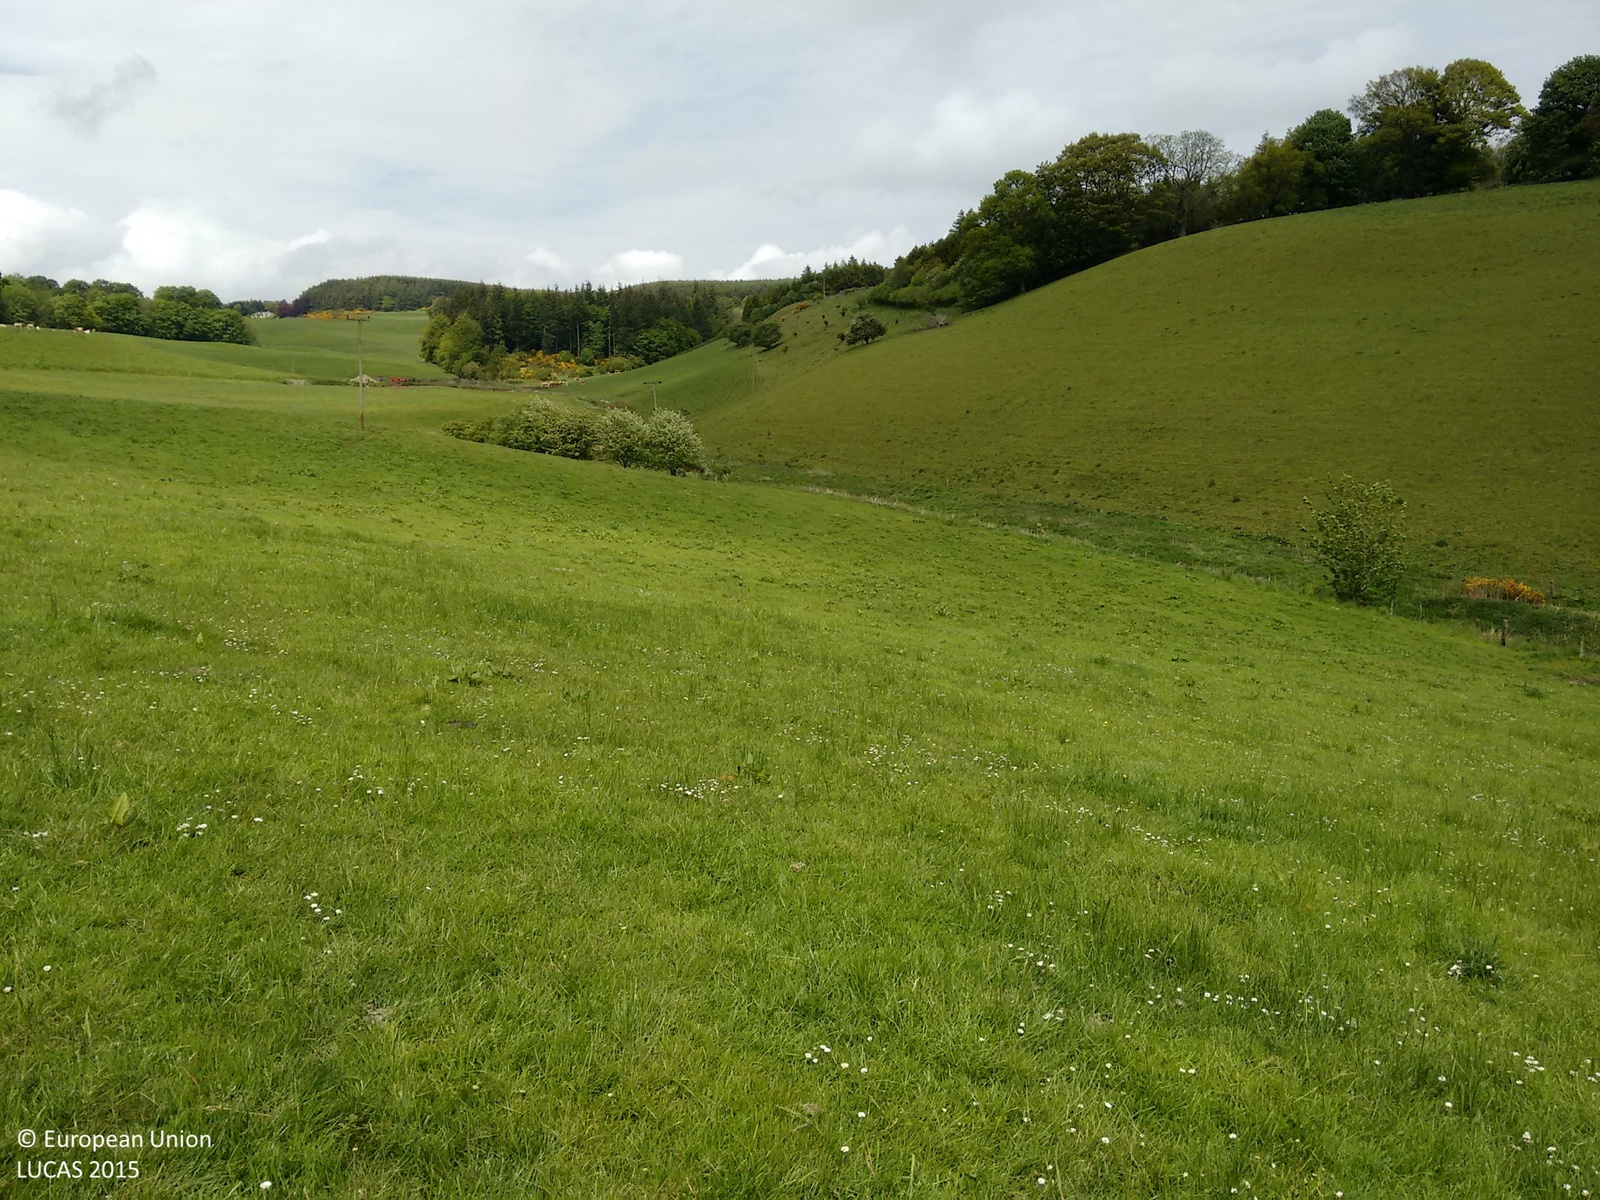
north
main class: Grassland
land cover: Grassland without tree/shrub cover
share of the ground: > 75 %
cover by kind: herbaceous plants 100 %
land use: Agriculture (excluding fallow land and kitchen gardens)
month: June
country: GB
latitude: 56.2939
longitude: -3.3054
